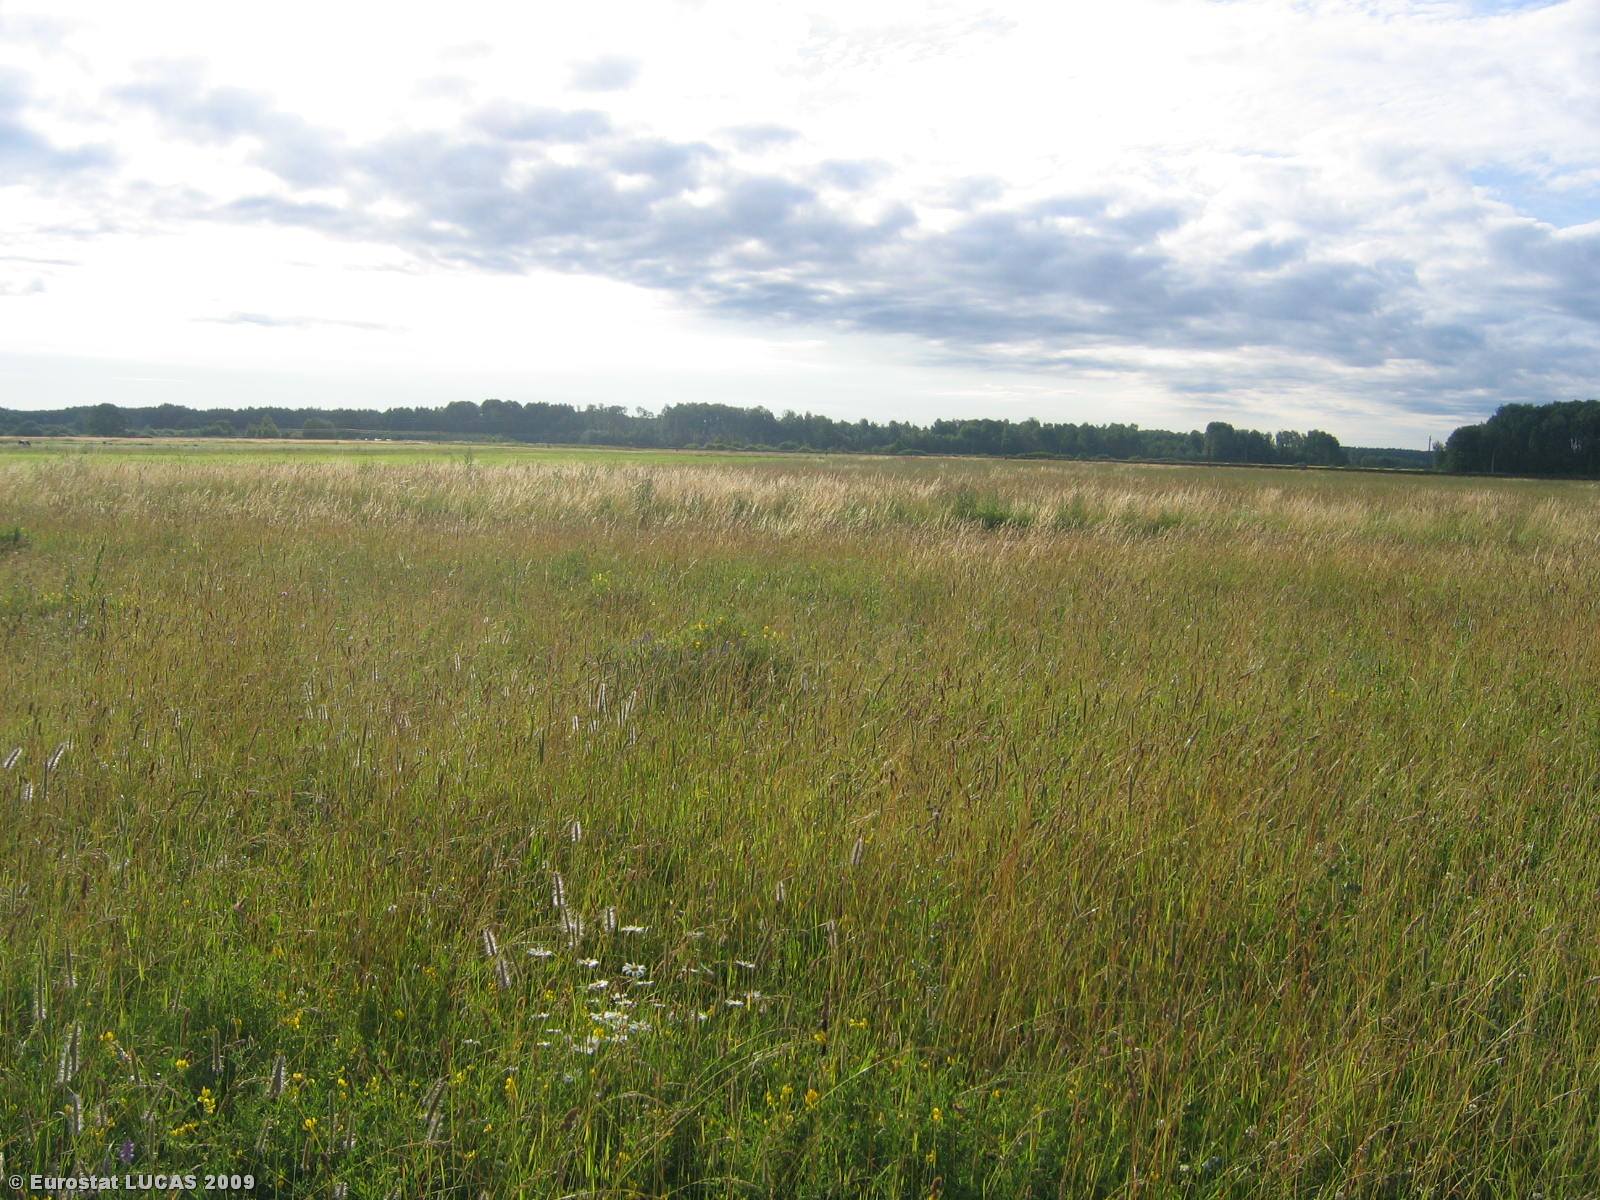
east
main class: Grassland
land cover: Grassland without tree/shrub cover
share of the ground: > 75 %
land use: Agriculture (excluding fallow land and kitchen gardens)
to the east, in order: Grassland without tree/shrub cover; Paved roads, cycling and walking lanes; Grassland without tree/shrub cover
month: July
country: LT
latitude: 55.3677
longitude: 22.7350
